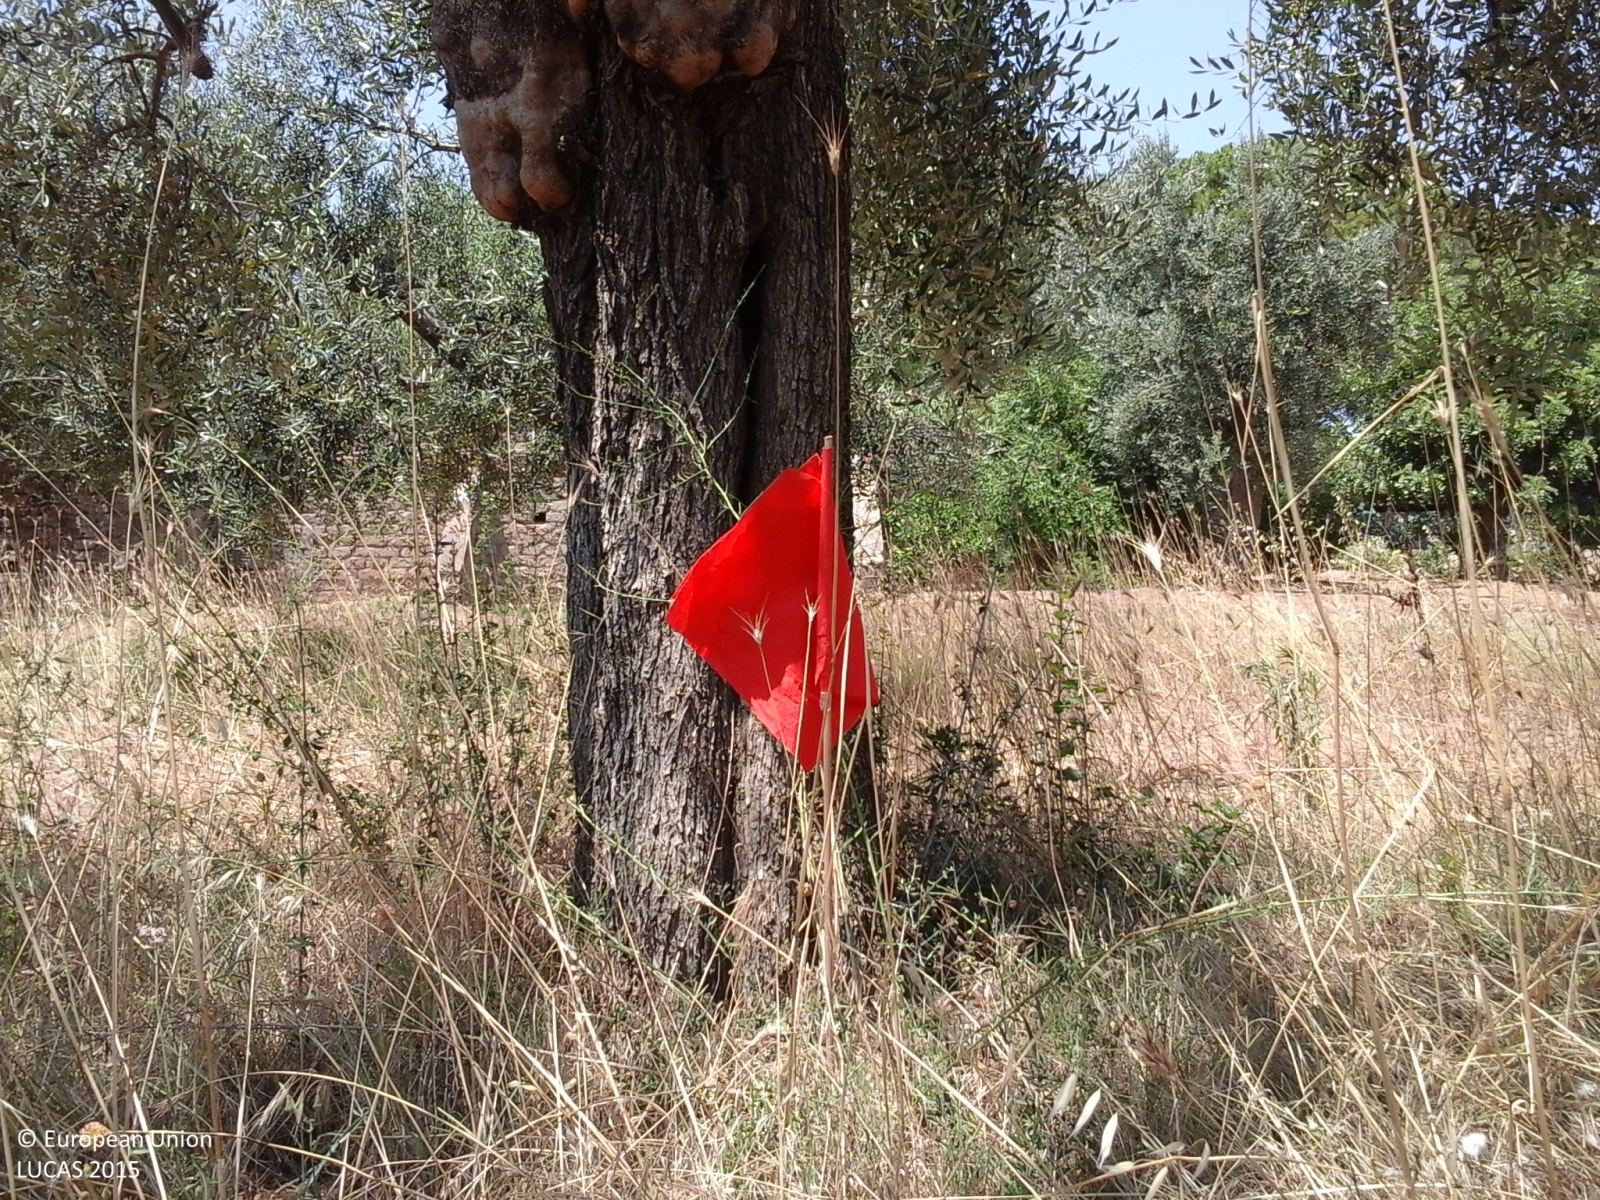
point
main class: Cropland
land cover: Olive groves
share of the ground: 50 - 75 %
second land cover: Grassland without tree/shrub cover
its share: 50 - 75 %
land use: Agriculture (excluding fallow land and kitchen gardens)
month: July
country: IT
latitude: 42.4266
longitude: 11.4656
